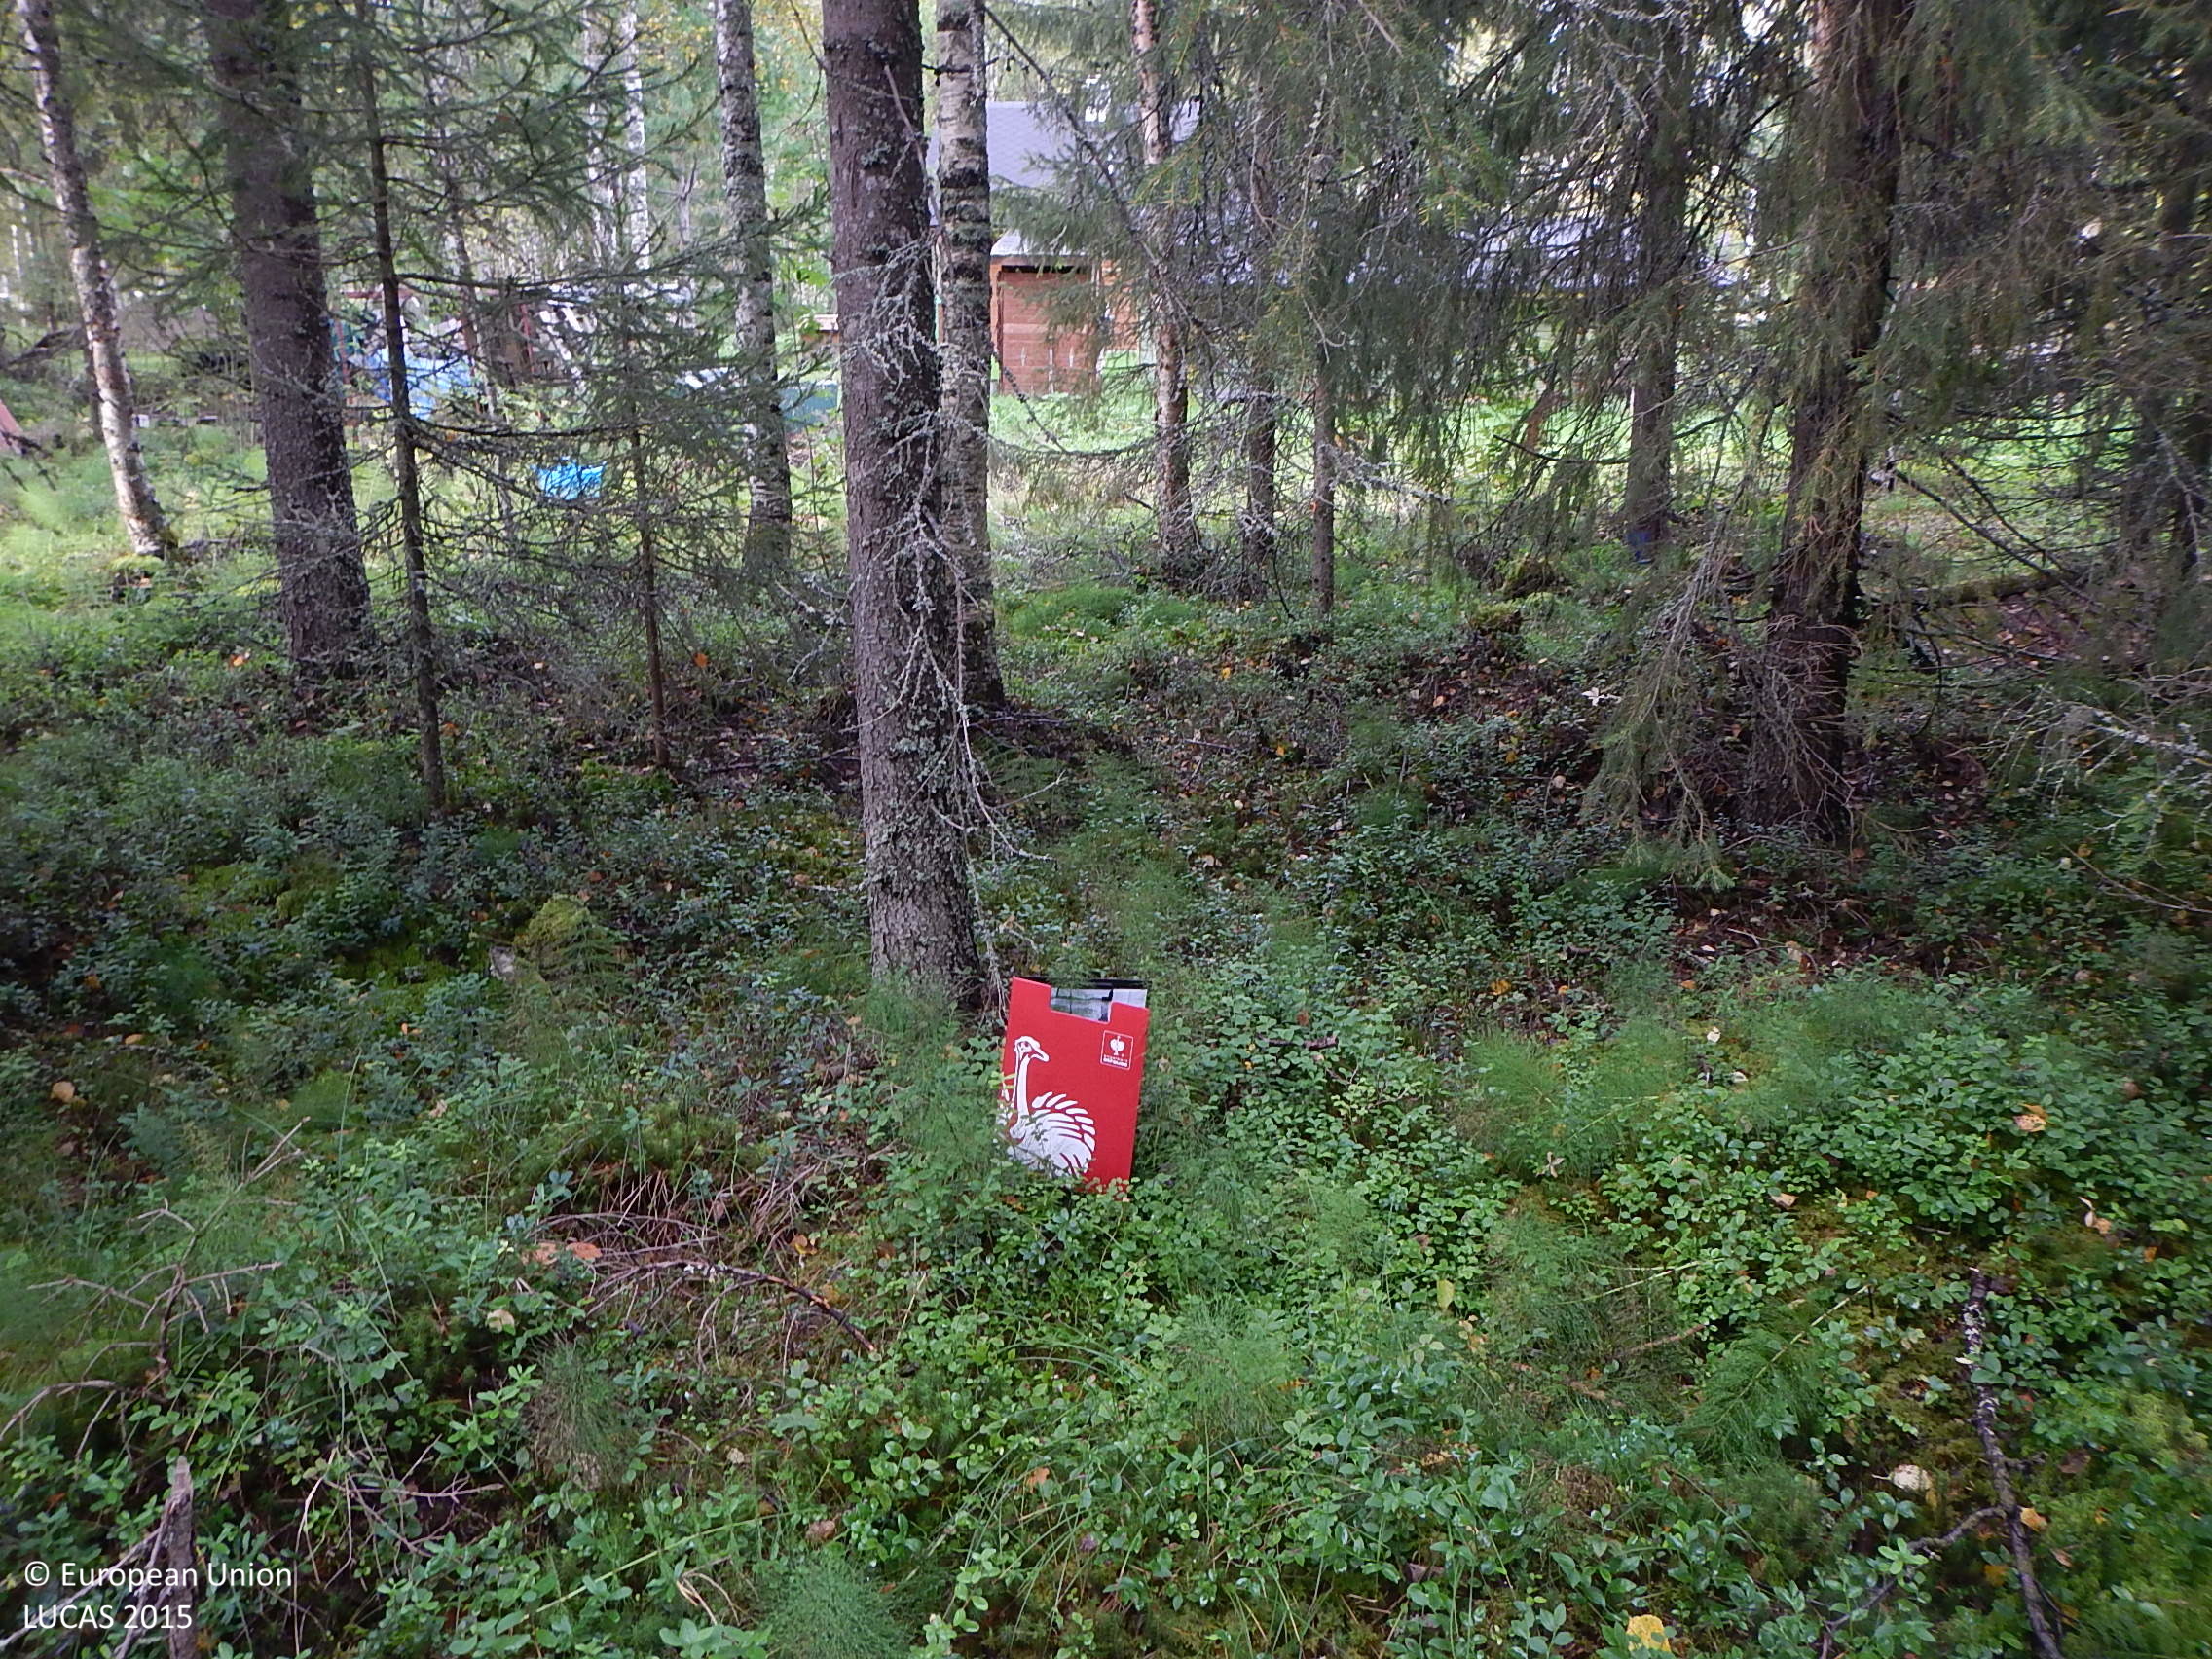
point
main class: Woodland
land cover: Spruce dominated mixed woodland
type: boreal forest
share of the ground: 50 - 75 %
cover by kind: coniferous forest trees 45 %, broadleaved forest trees 25 %, shrubs 25 %, lichens and mosses 5 %
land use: Forestry
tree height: > 5 m
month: August
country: FI
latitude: 65.7018
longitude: 27.3494
